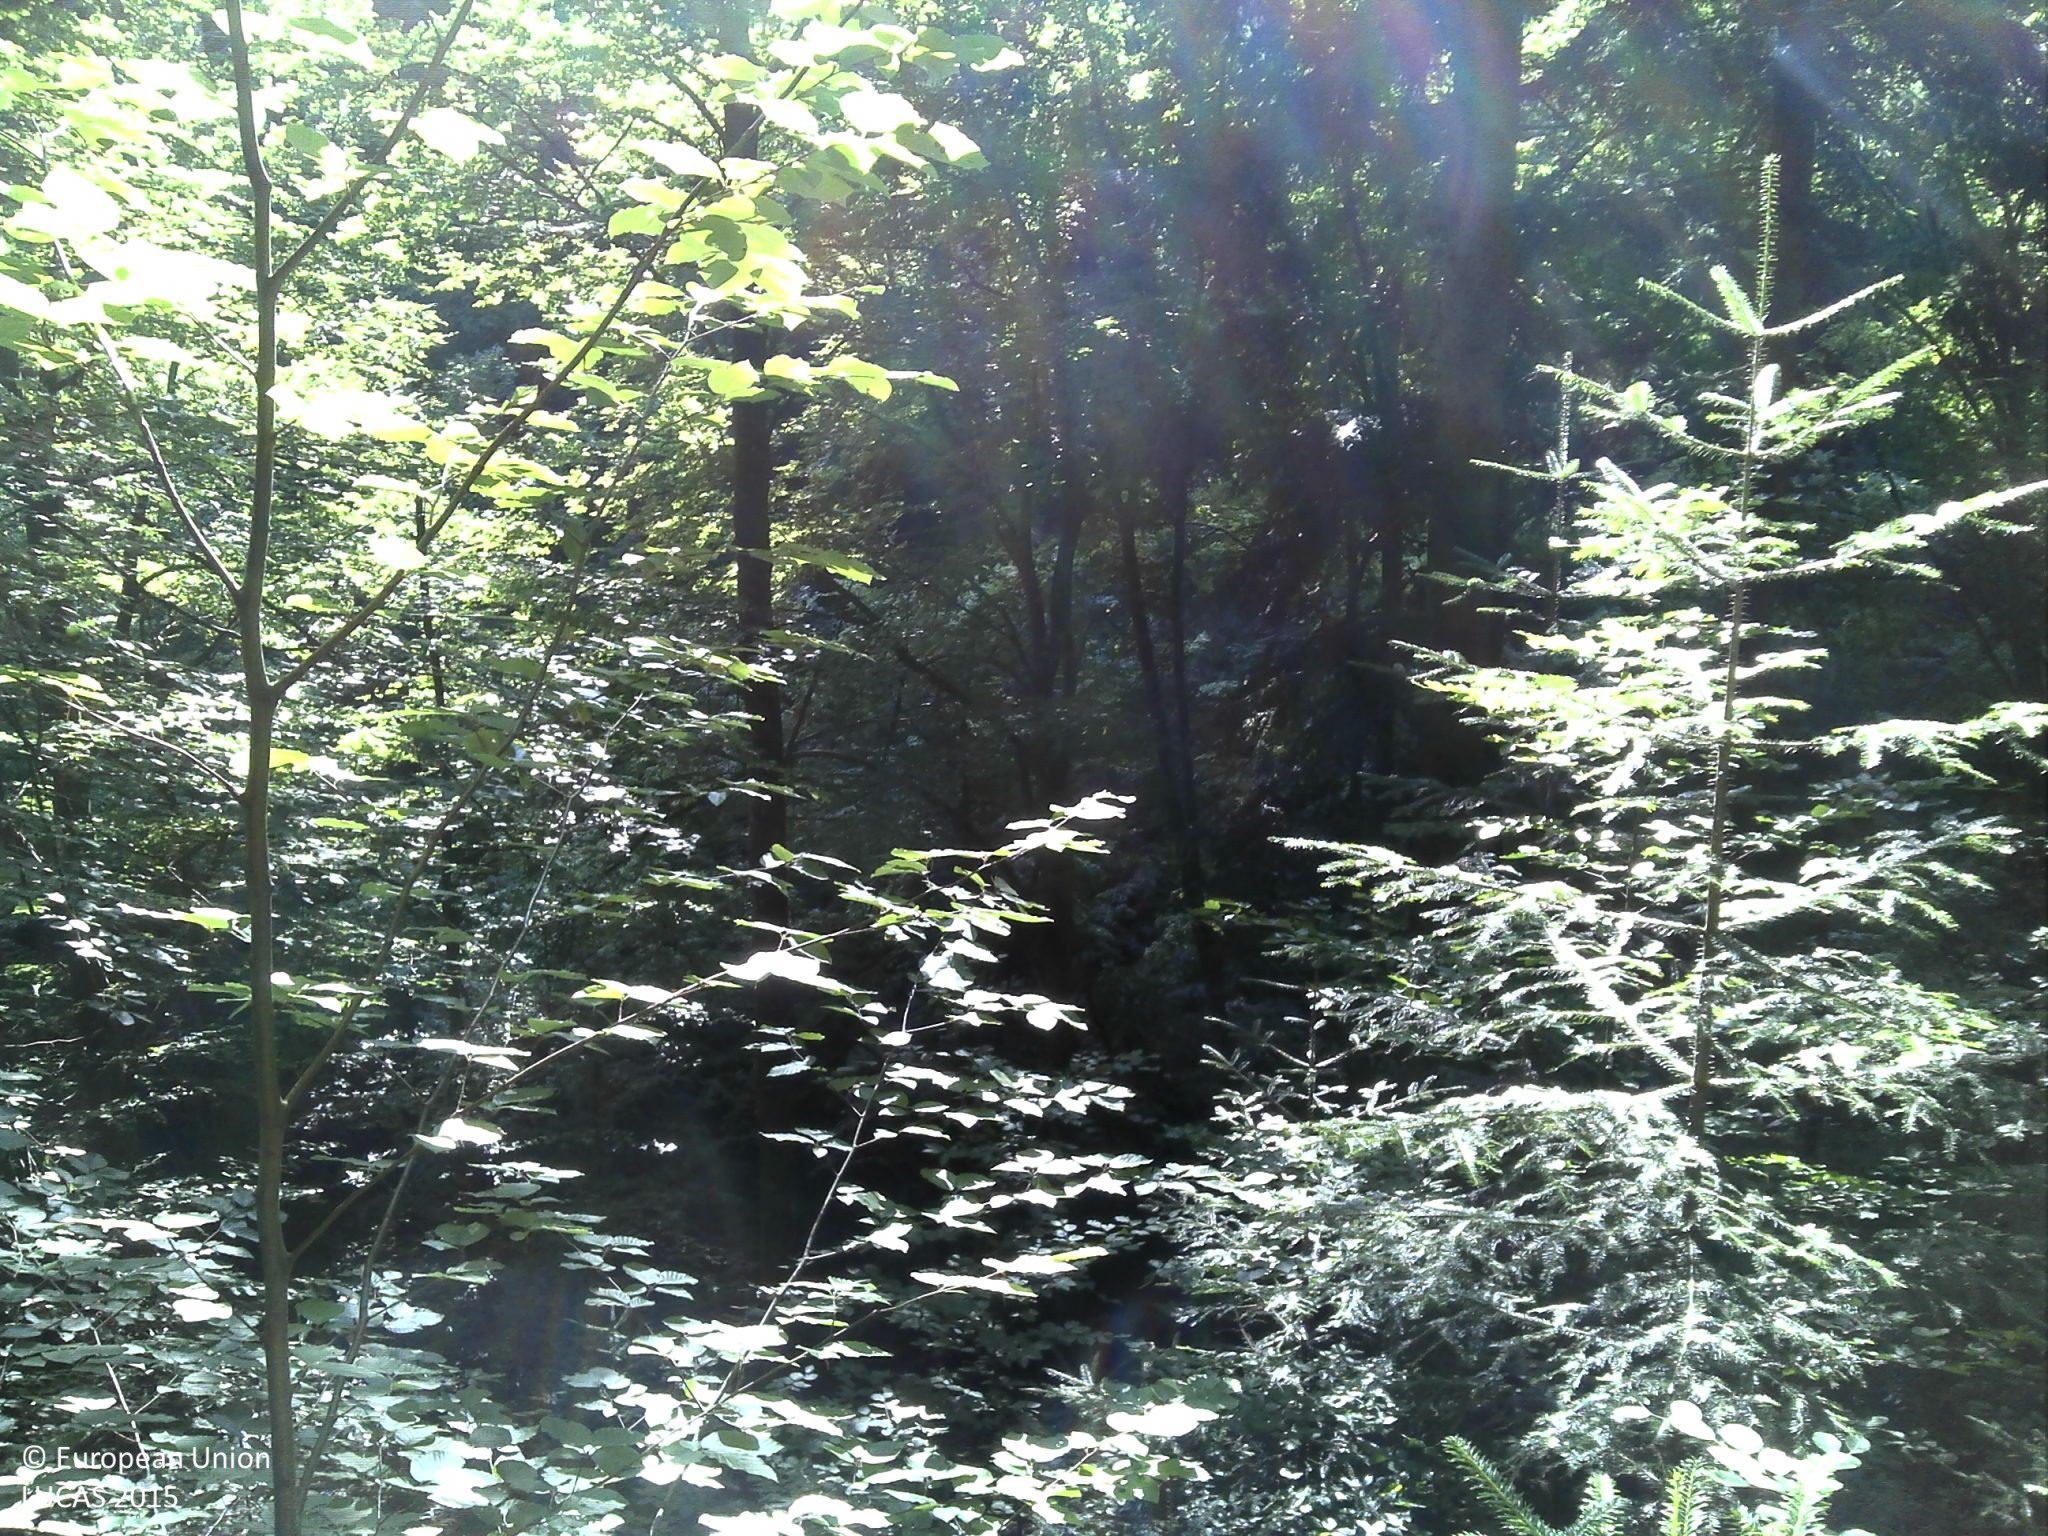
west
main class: Woodland
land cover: Pine dominated mixed woodland
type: broadleaved evergreen forest
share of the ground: > 75 %
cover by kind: coniferous forest trees 50 %, broadleaved forest trees 30 %, lichens and mosses 20 %
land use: Forestry
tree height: > 5 m
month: June
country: HR
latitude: 45.5615
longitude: 17.5222
